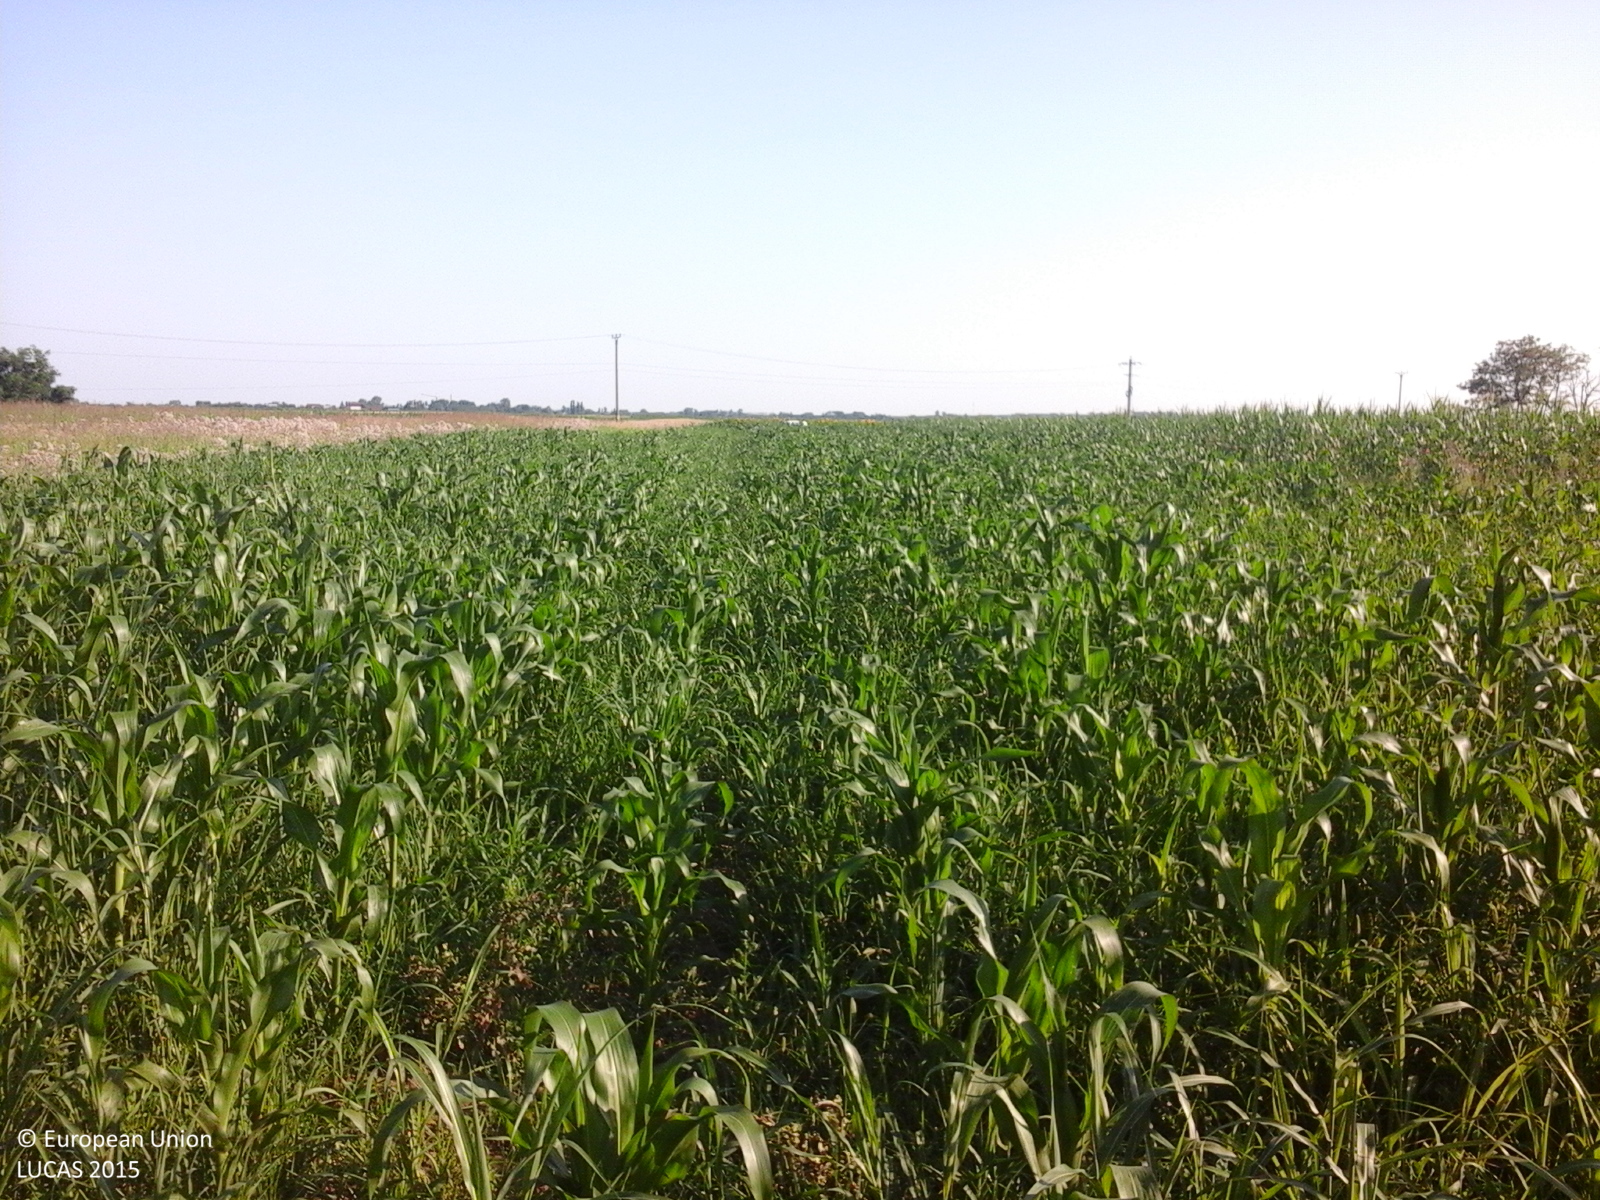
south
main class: Cropland
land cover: Maize
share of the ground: > 75 %
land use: Agriculture (excluding fallow land and kitchen gardens)
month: July
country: RO
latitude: 44.3947
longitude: 24.3159
